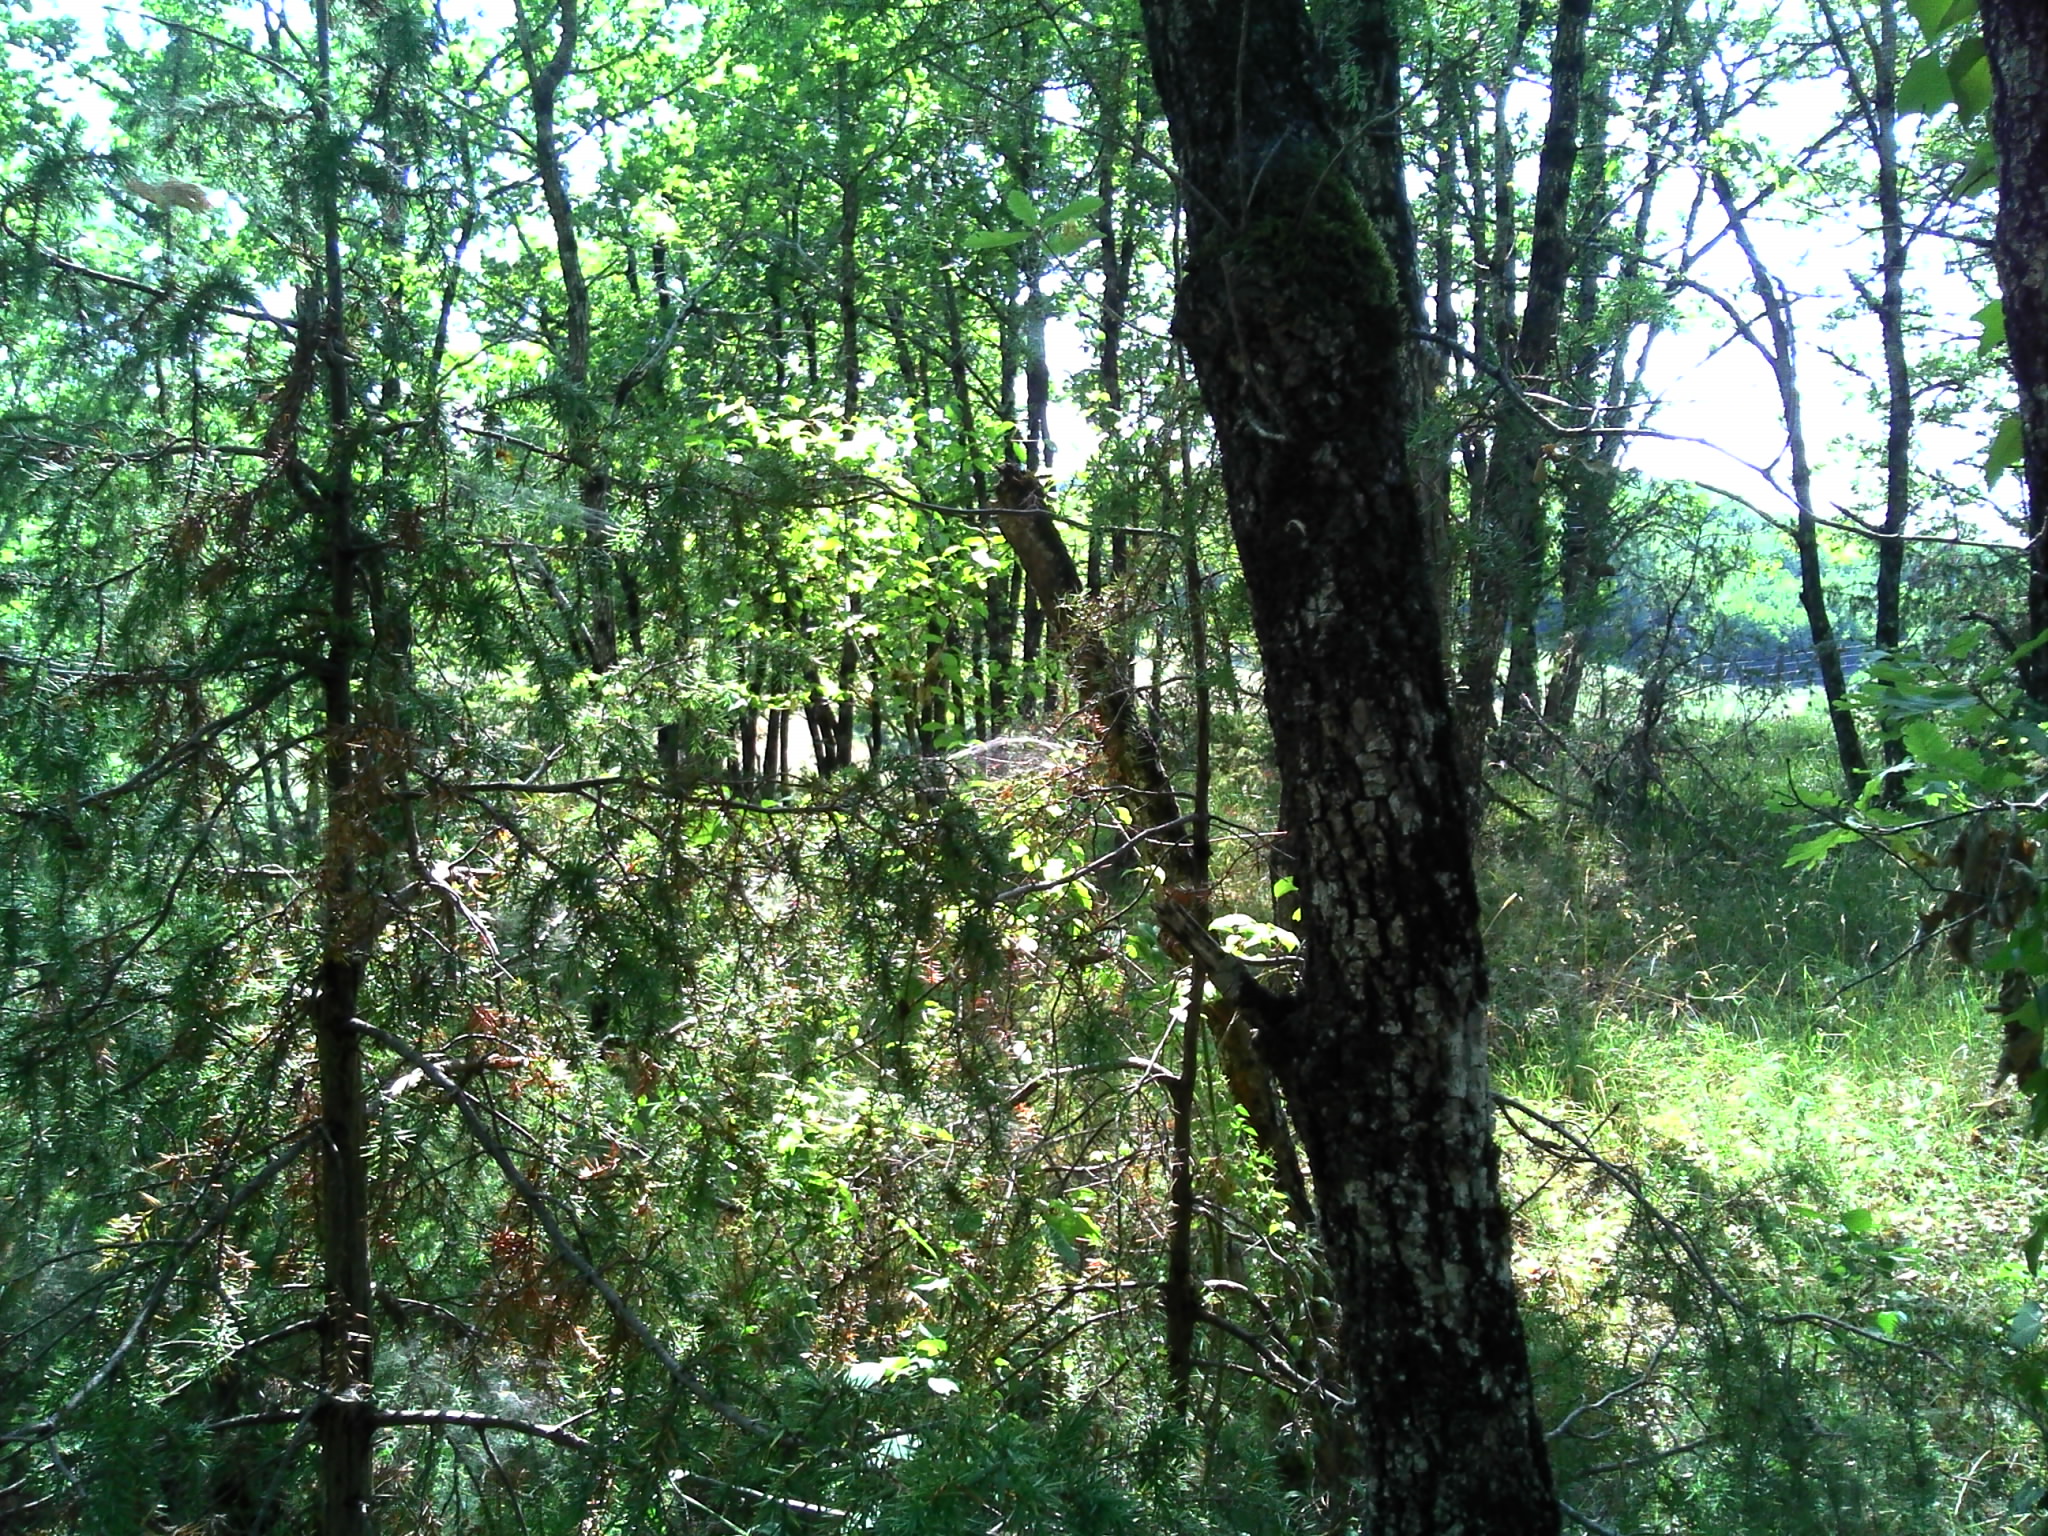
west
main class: Woodland
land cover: Broadleaved woodland
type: thermophilous deciduous forest
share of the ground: > 75 %
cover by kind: broadleaved forest trees 95 %, herbaceous plants 5 %
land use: Forestry
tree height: > 5 m
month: June
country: FR
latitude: 44.9748
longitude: 1.4364
